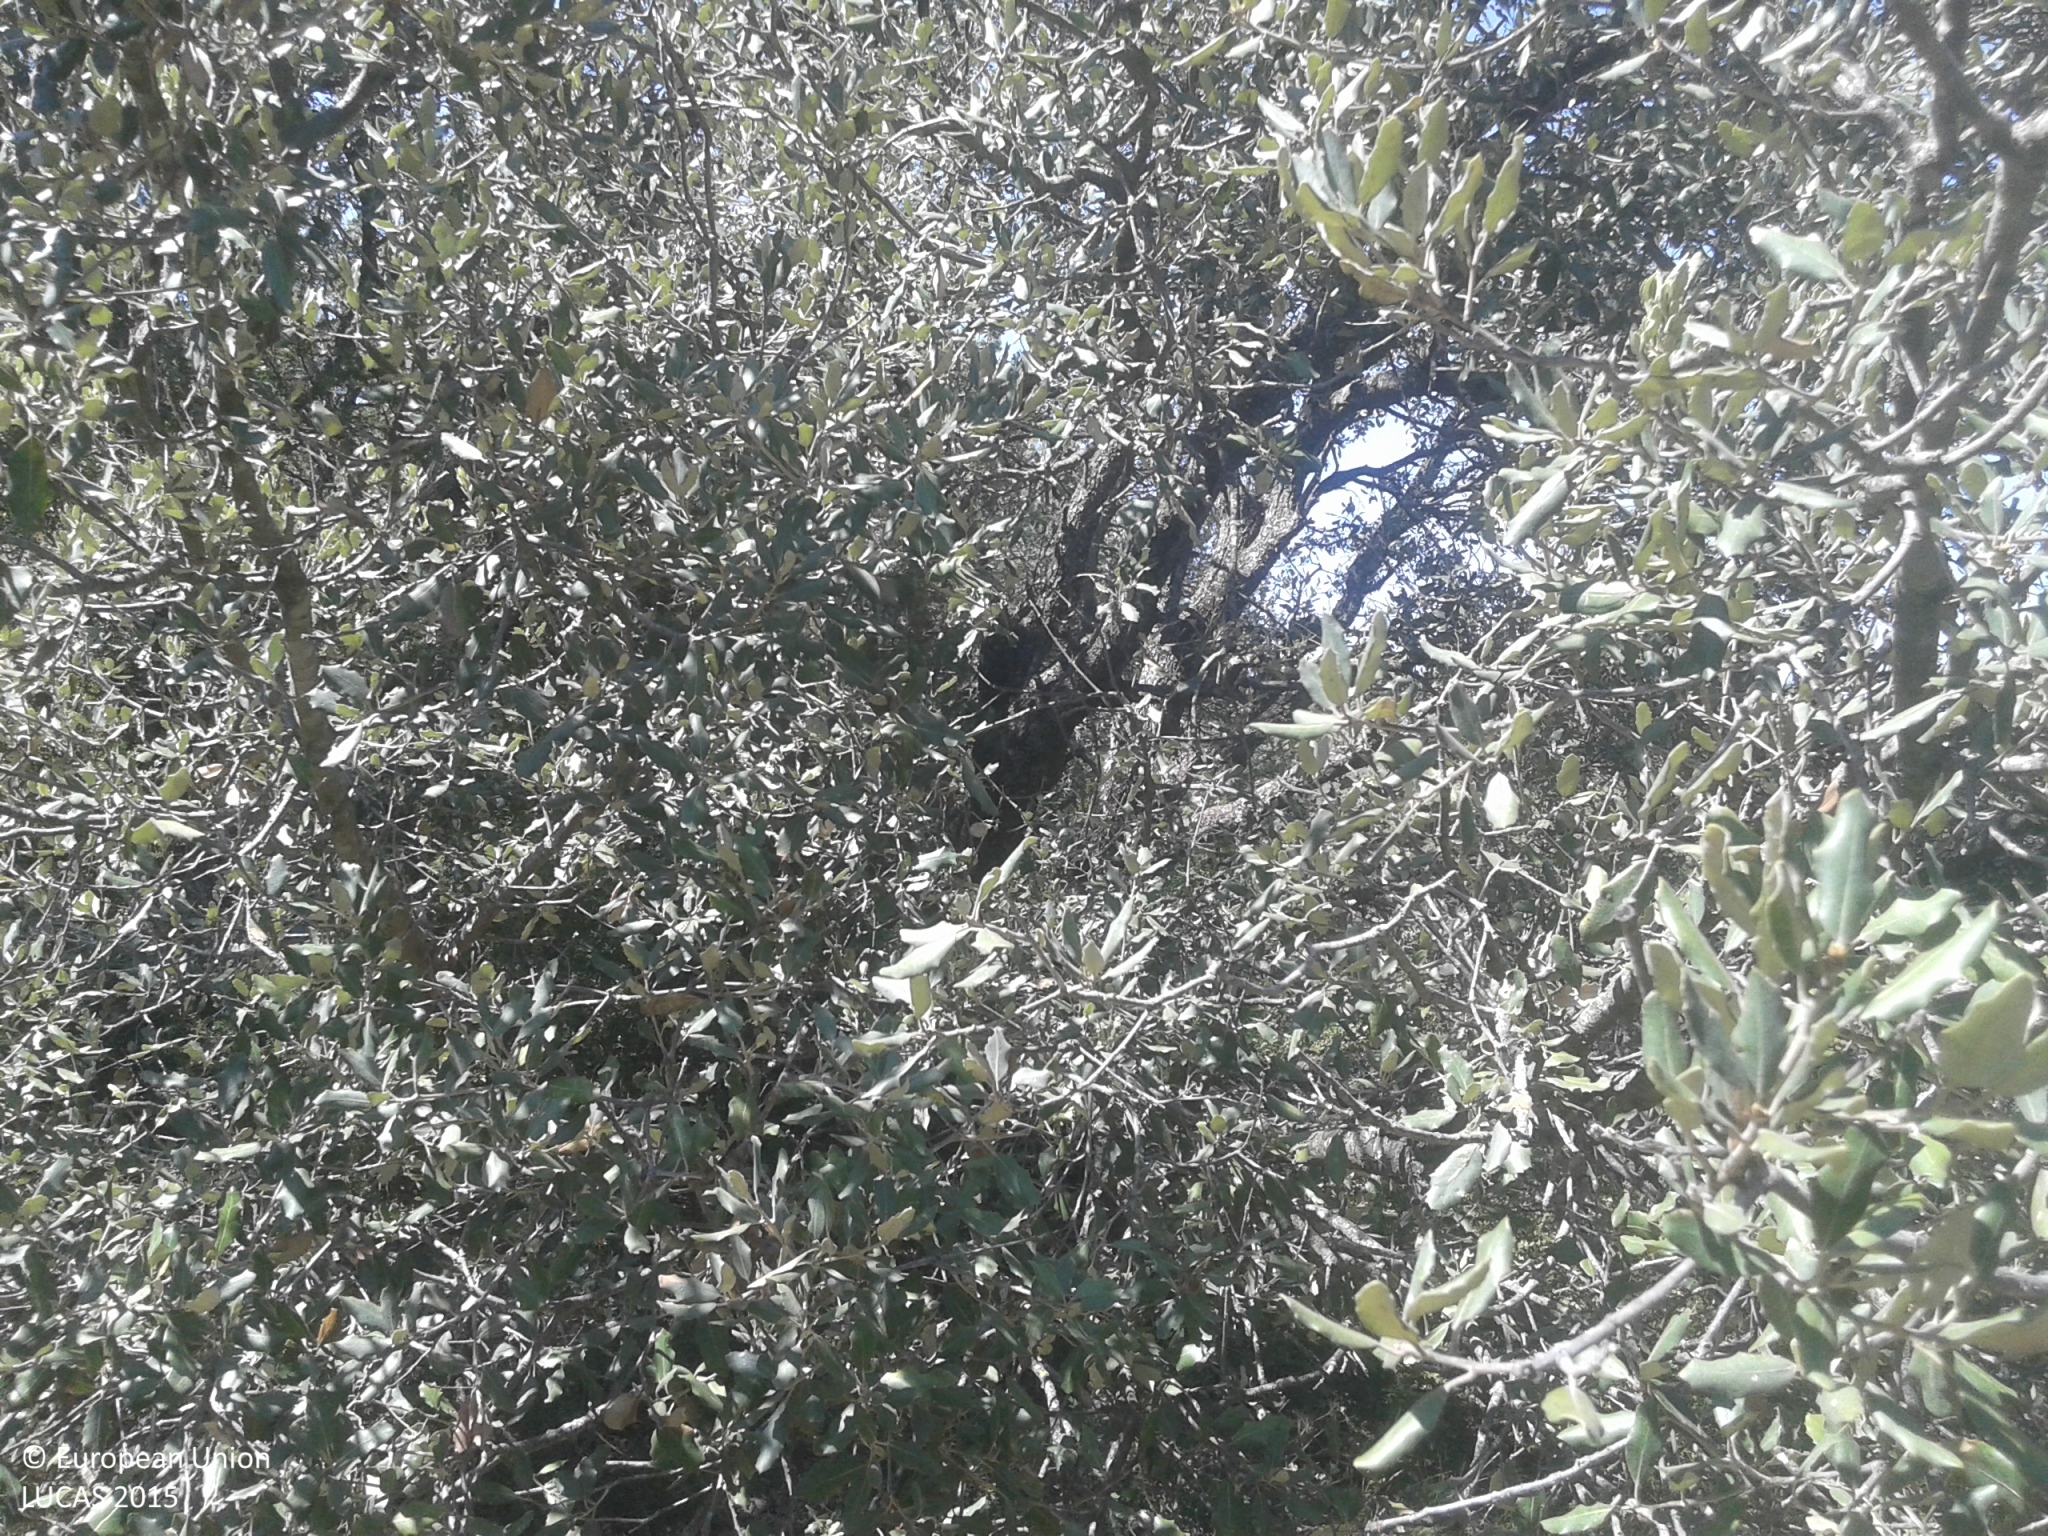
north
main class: Woodland
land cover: Broadleaved woodland
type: broadleaved evergreen forest
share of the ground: 50 - 75 %
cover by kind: broadleaved forest trees 70 %, shrubs 20 %, herbaceous plants 10 %
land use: Semi-natural and natural areas not in use
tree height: > 5 m
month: July
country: ES
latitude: 42.0822
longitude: 1.1256
